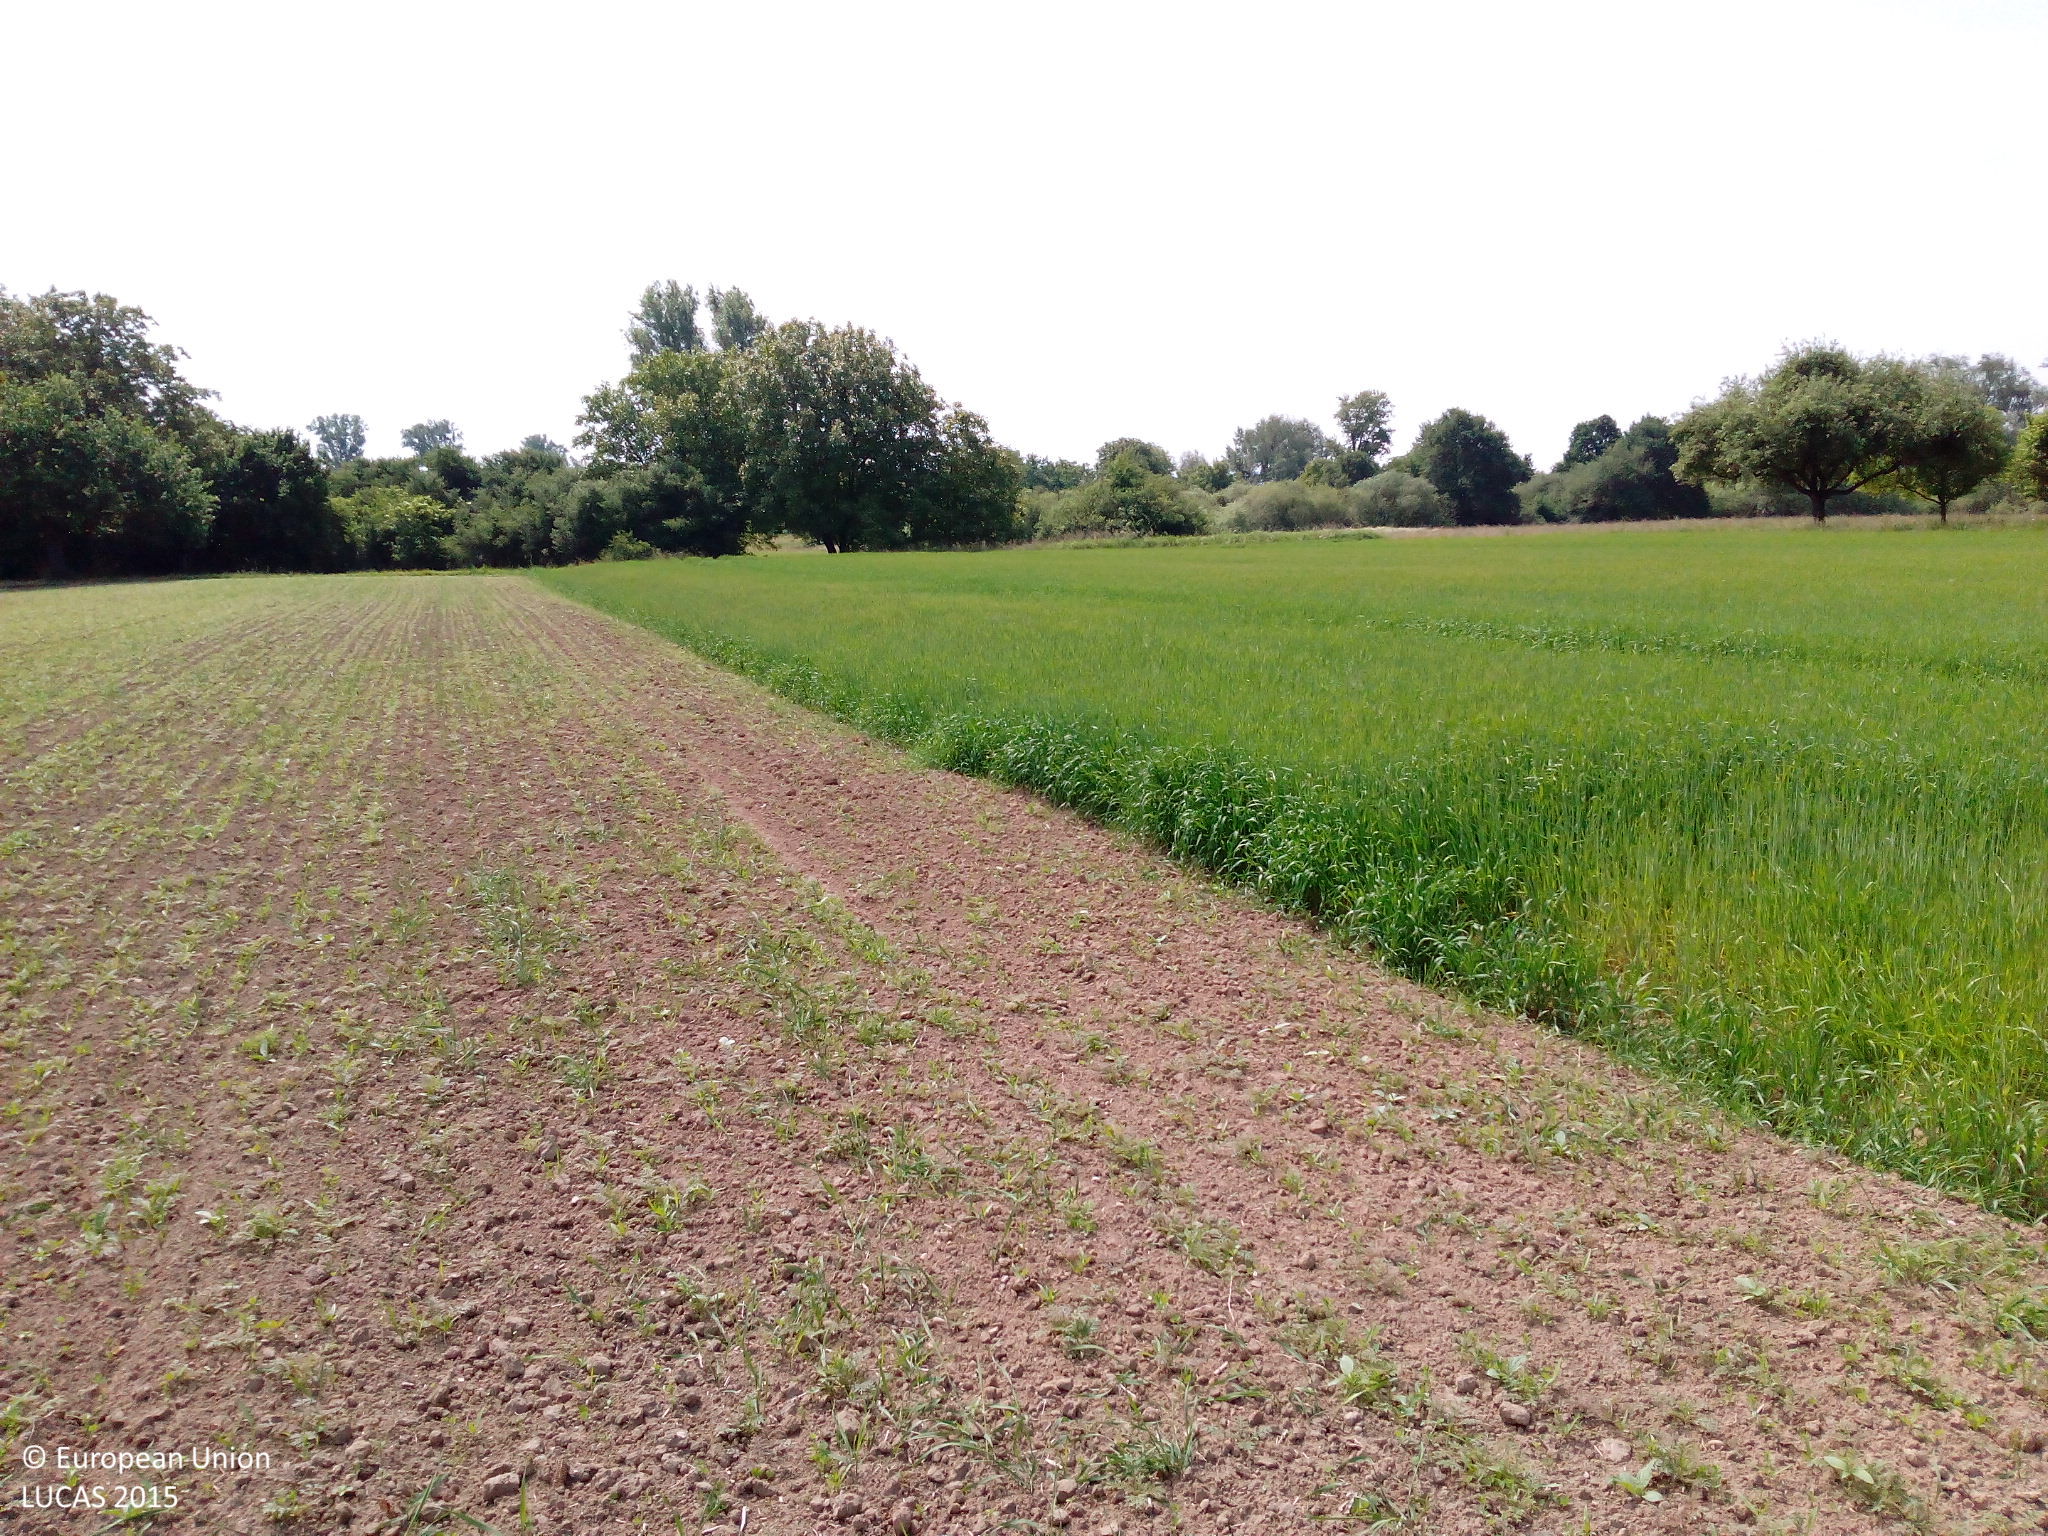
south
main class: Cropland
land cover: Other leguminous and mixtures for fodder
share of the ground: < 10 %
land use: Agriculture (excluding fallow land and kitchen gardens)
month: May
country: DE
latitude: 48.8925
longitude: 8.1866
